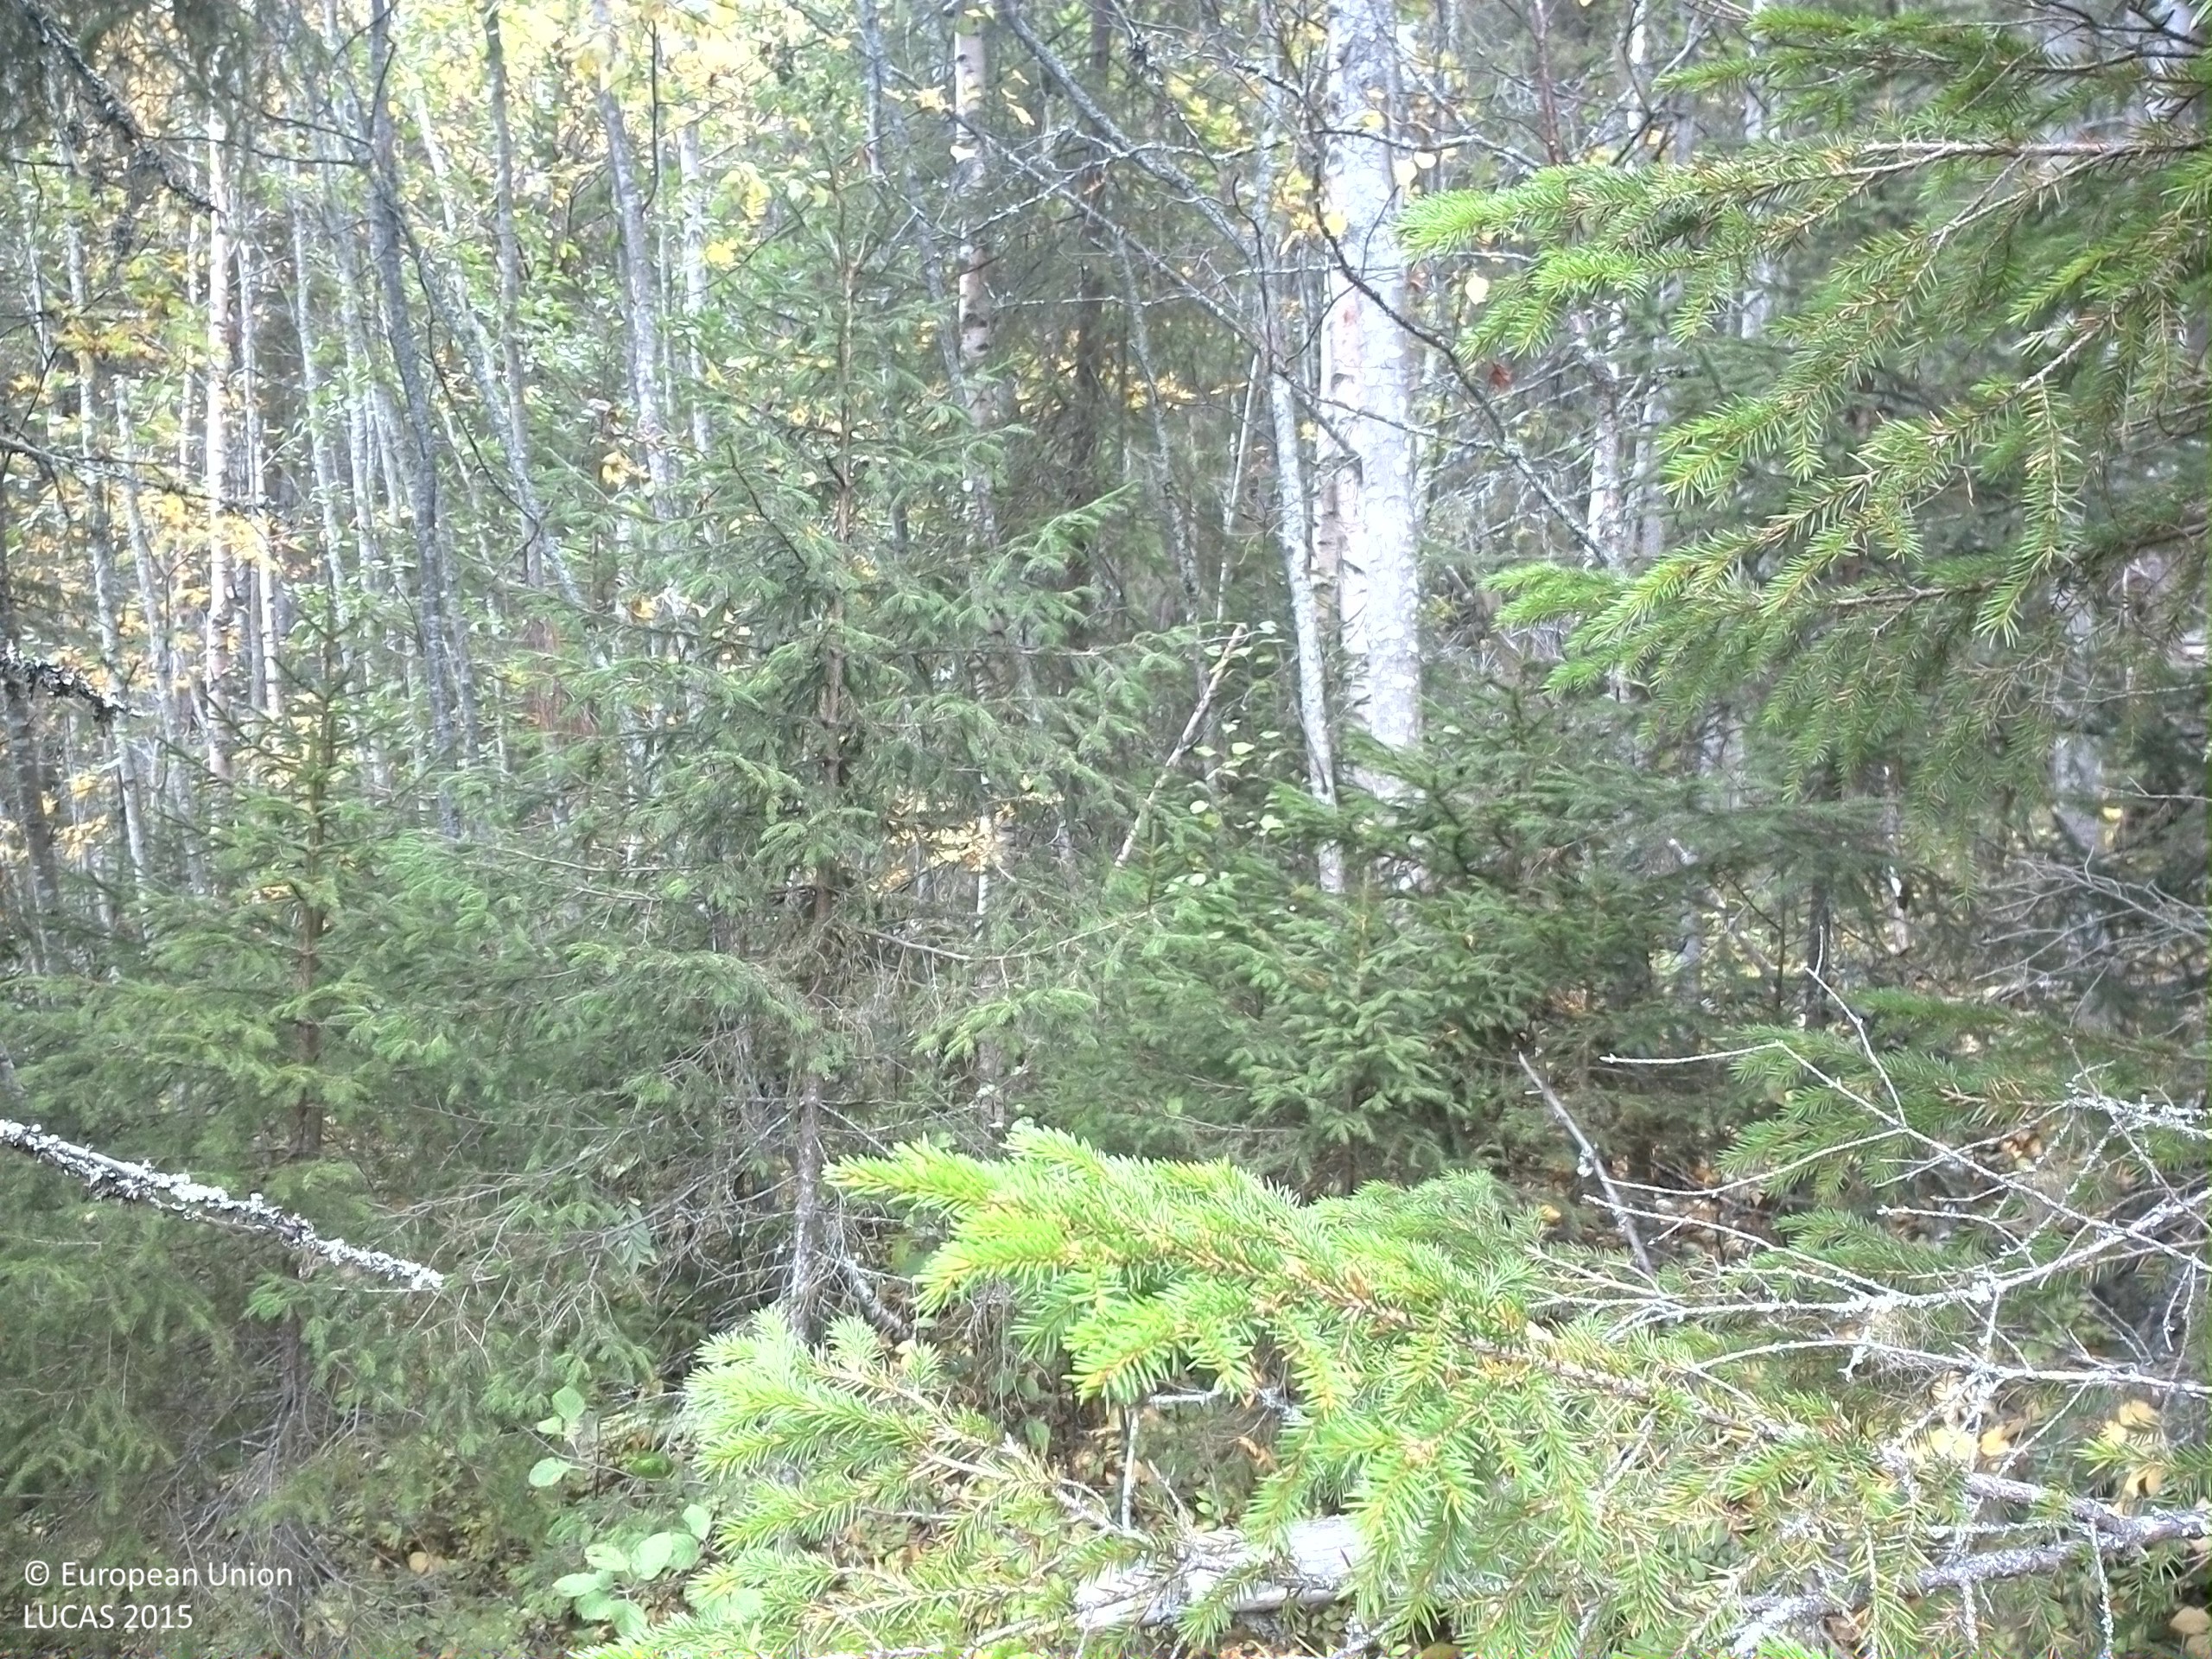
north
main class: Woodland
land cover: Spruce dominated mixed woodland
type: boreal forest
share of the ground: 50 - 75 %
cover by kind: coniferous forest trees 40 %, broadleaved forest trees 25 %, shrubs 20 %, lichens and mosses 10 %, herbaceous plants 5 %
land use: Forestry
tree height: > 5 m
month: October
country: SE
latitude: 64.2151
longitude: 15.9252
